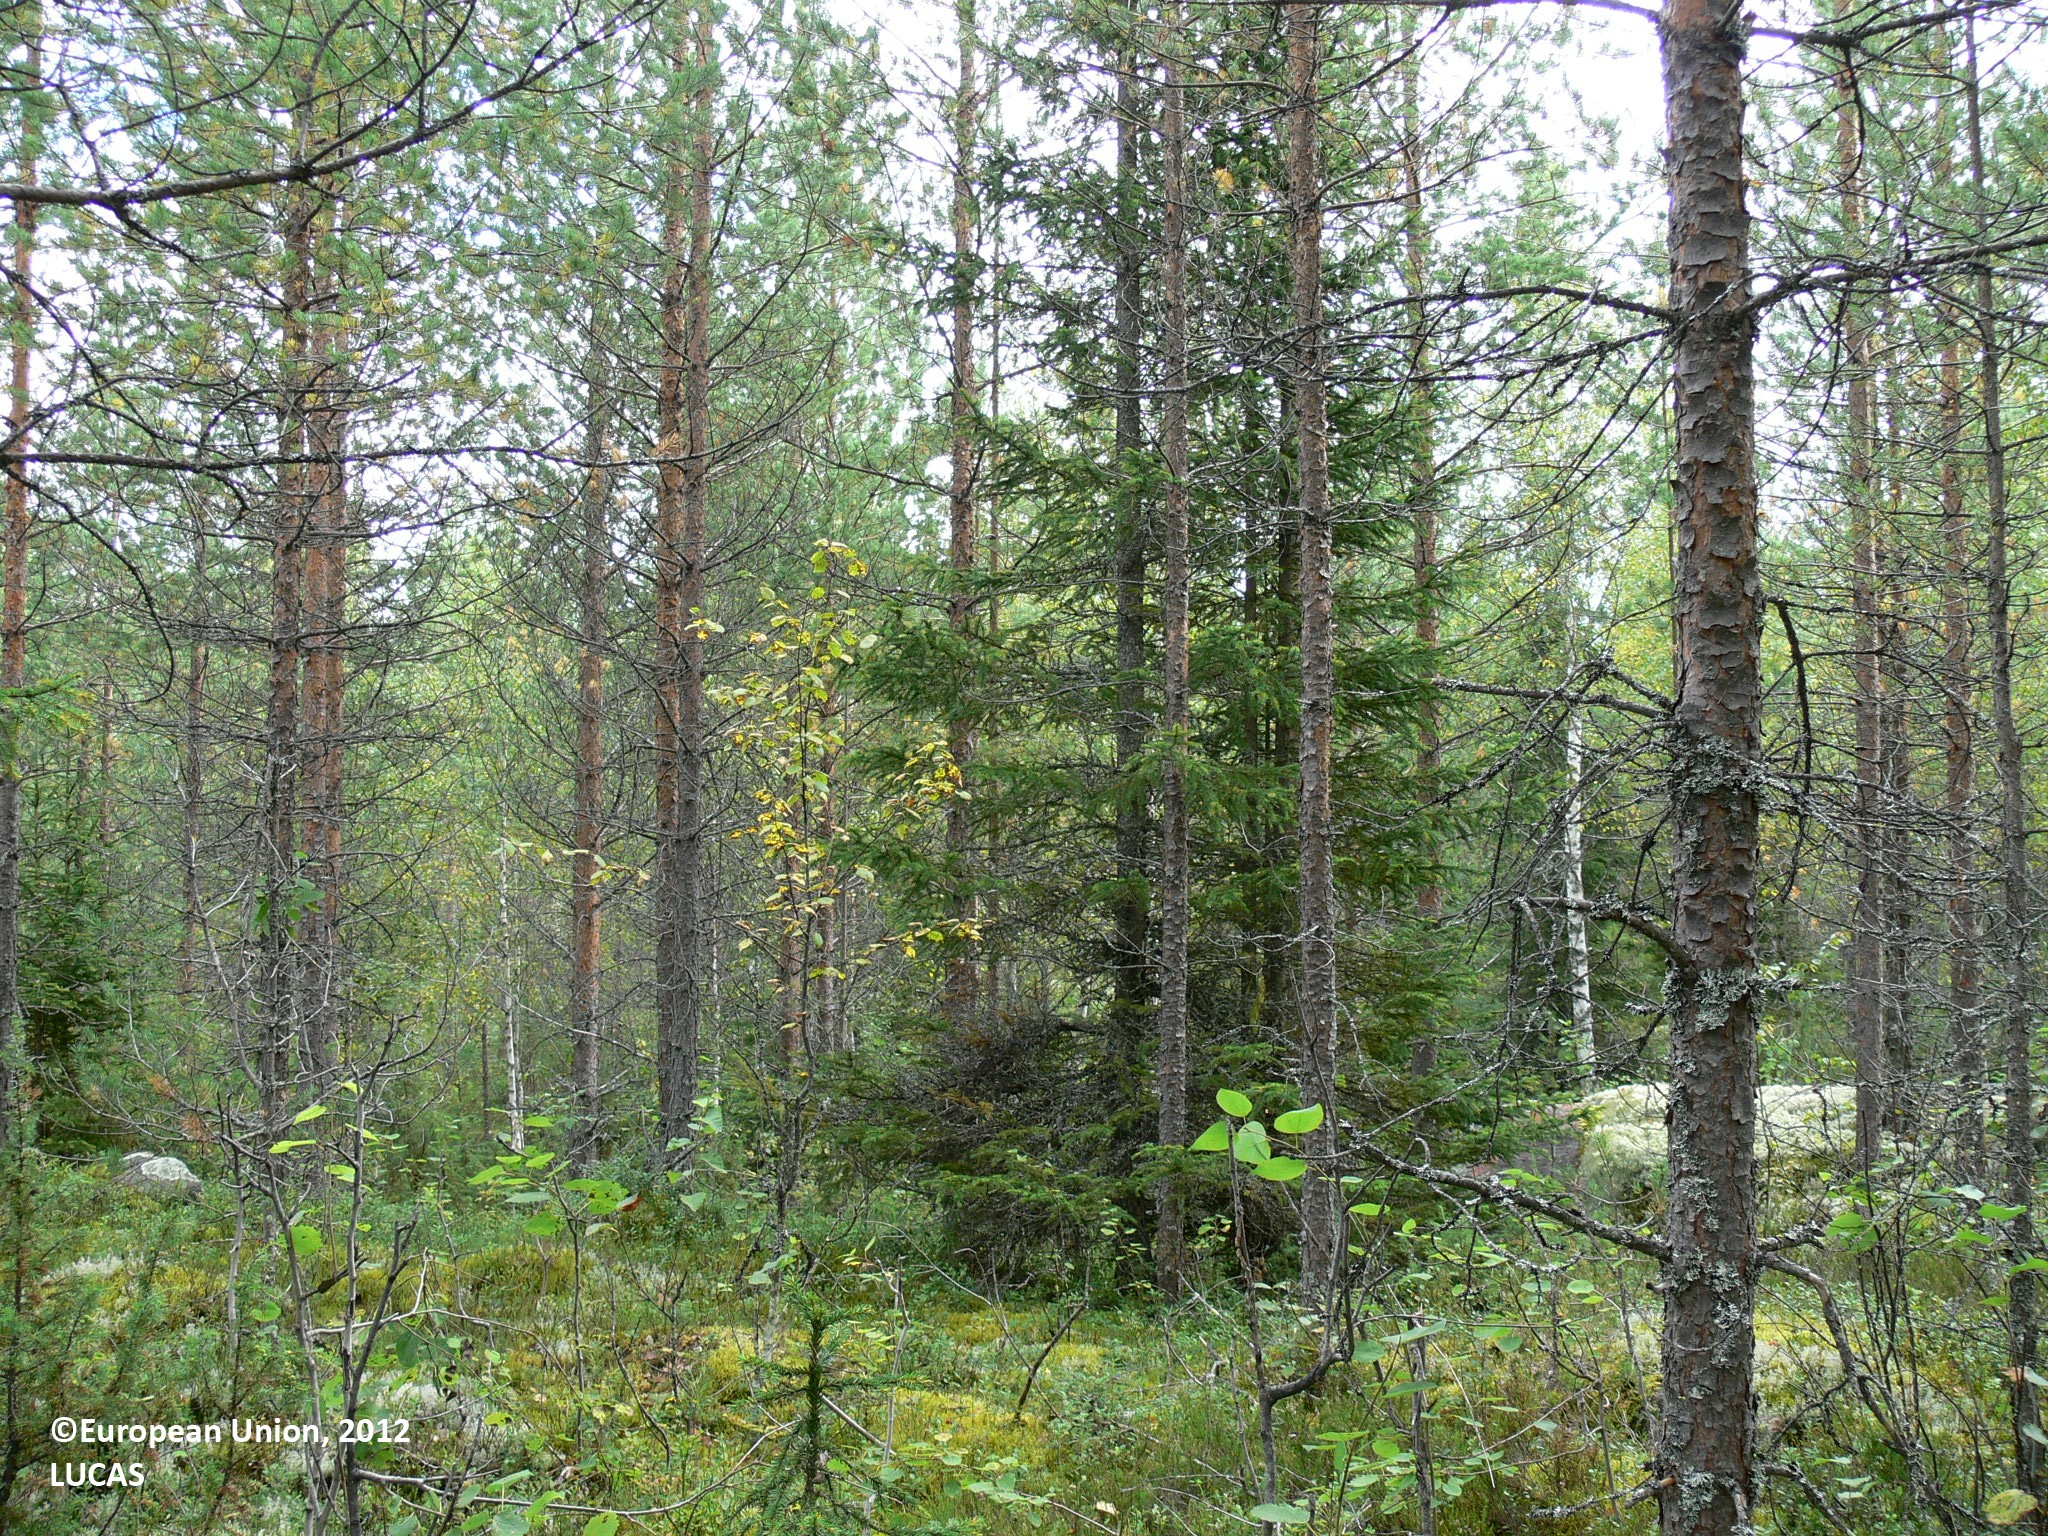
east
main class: Woodland
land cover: Other mixed woodland
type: boreal forest
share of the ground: > 75 %
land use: Forestry
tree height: > 5 m
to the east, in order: Other mixed woodland; Pine dominated mixed woodland; Ditches and canals; Pine dominated coniferous woodland; Ditches and canals; Pine dominated coniferous woodland; Ditches and canals; Pine dominated coniferous woodland; Other mixed woodland
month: August
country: FI
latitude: 63.2861
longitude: 30.3025
